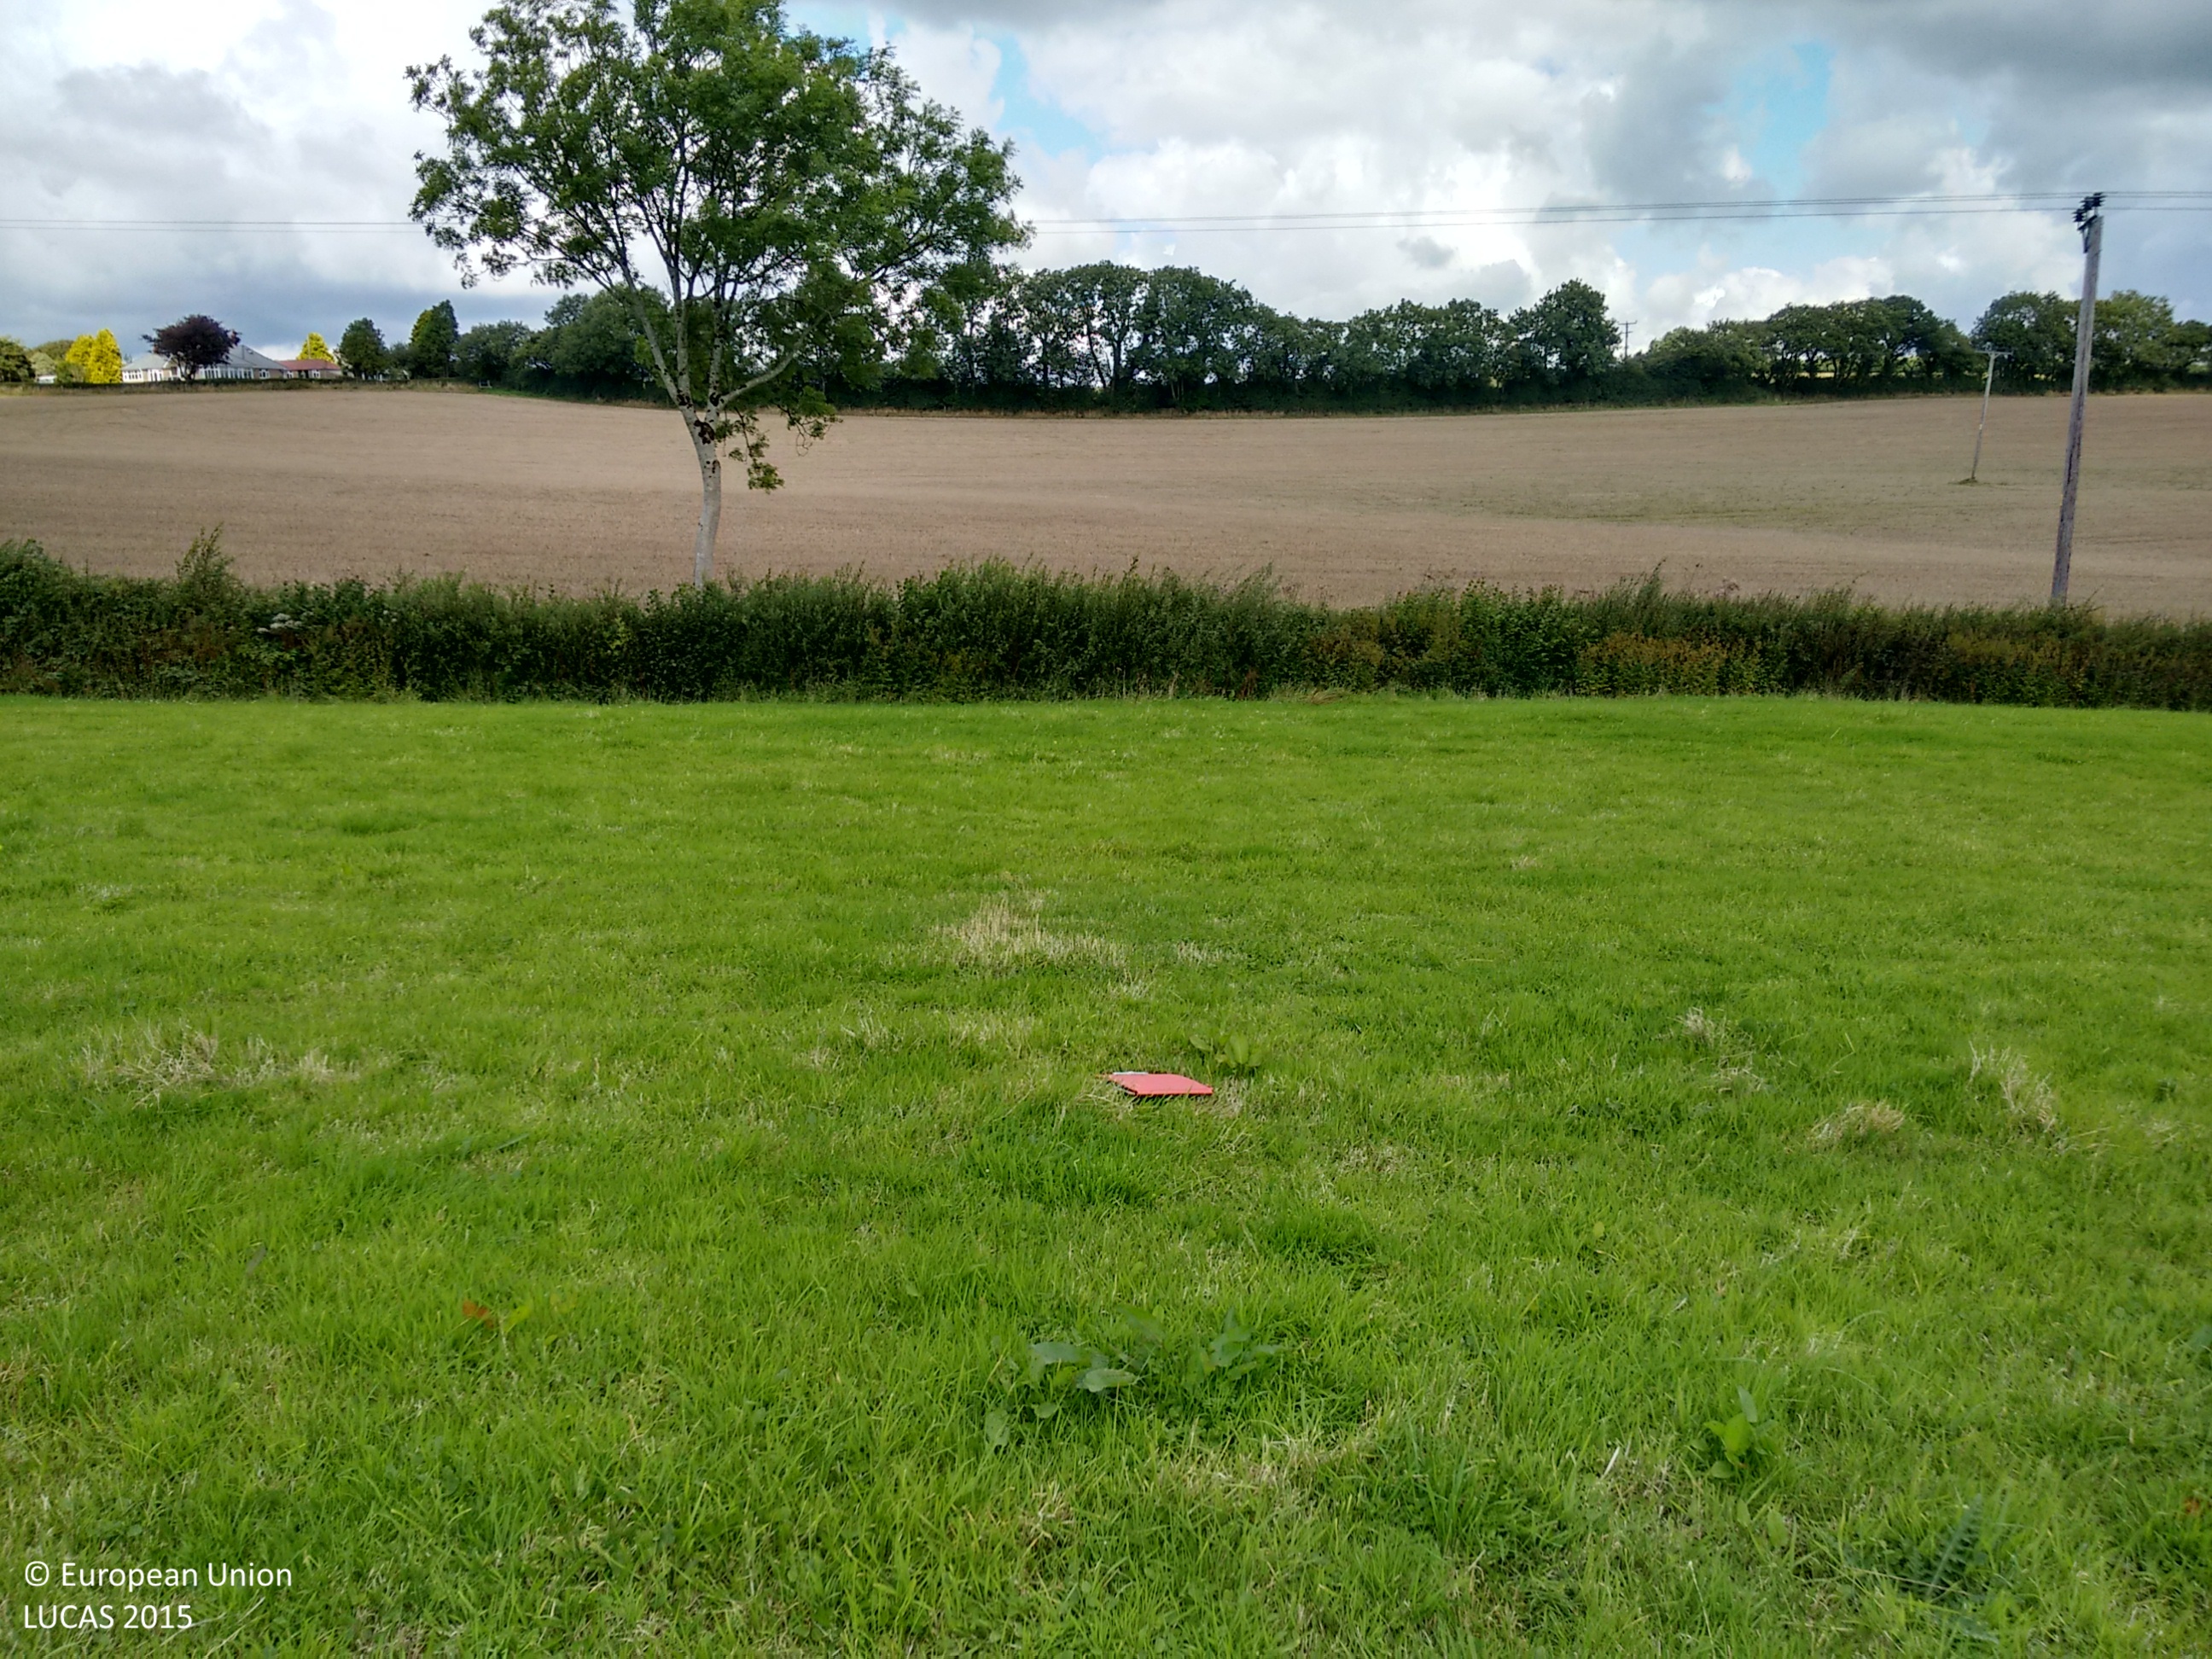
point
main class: Grassland
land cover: Grassland without tree/shrub cover
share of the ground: > 75 %
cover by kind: herbaceous plants 100 %
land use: Agriculture (excluding fallow land and kitchen gardens)
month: September
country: GB
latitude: 50.8622
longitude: -3.8873
